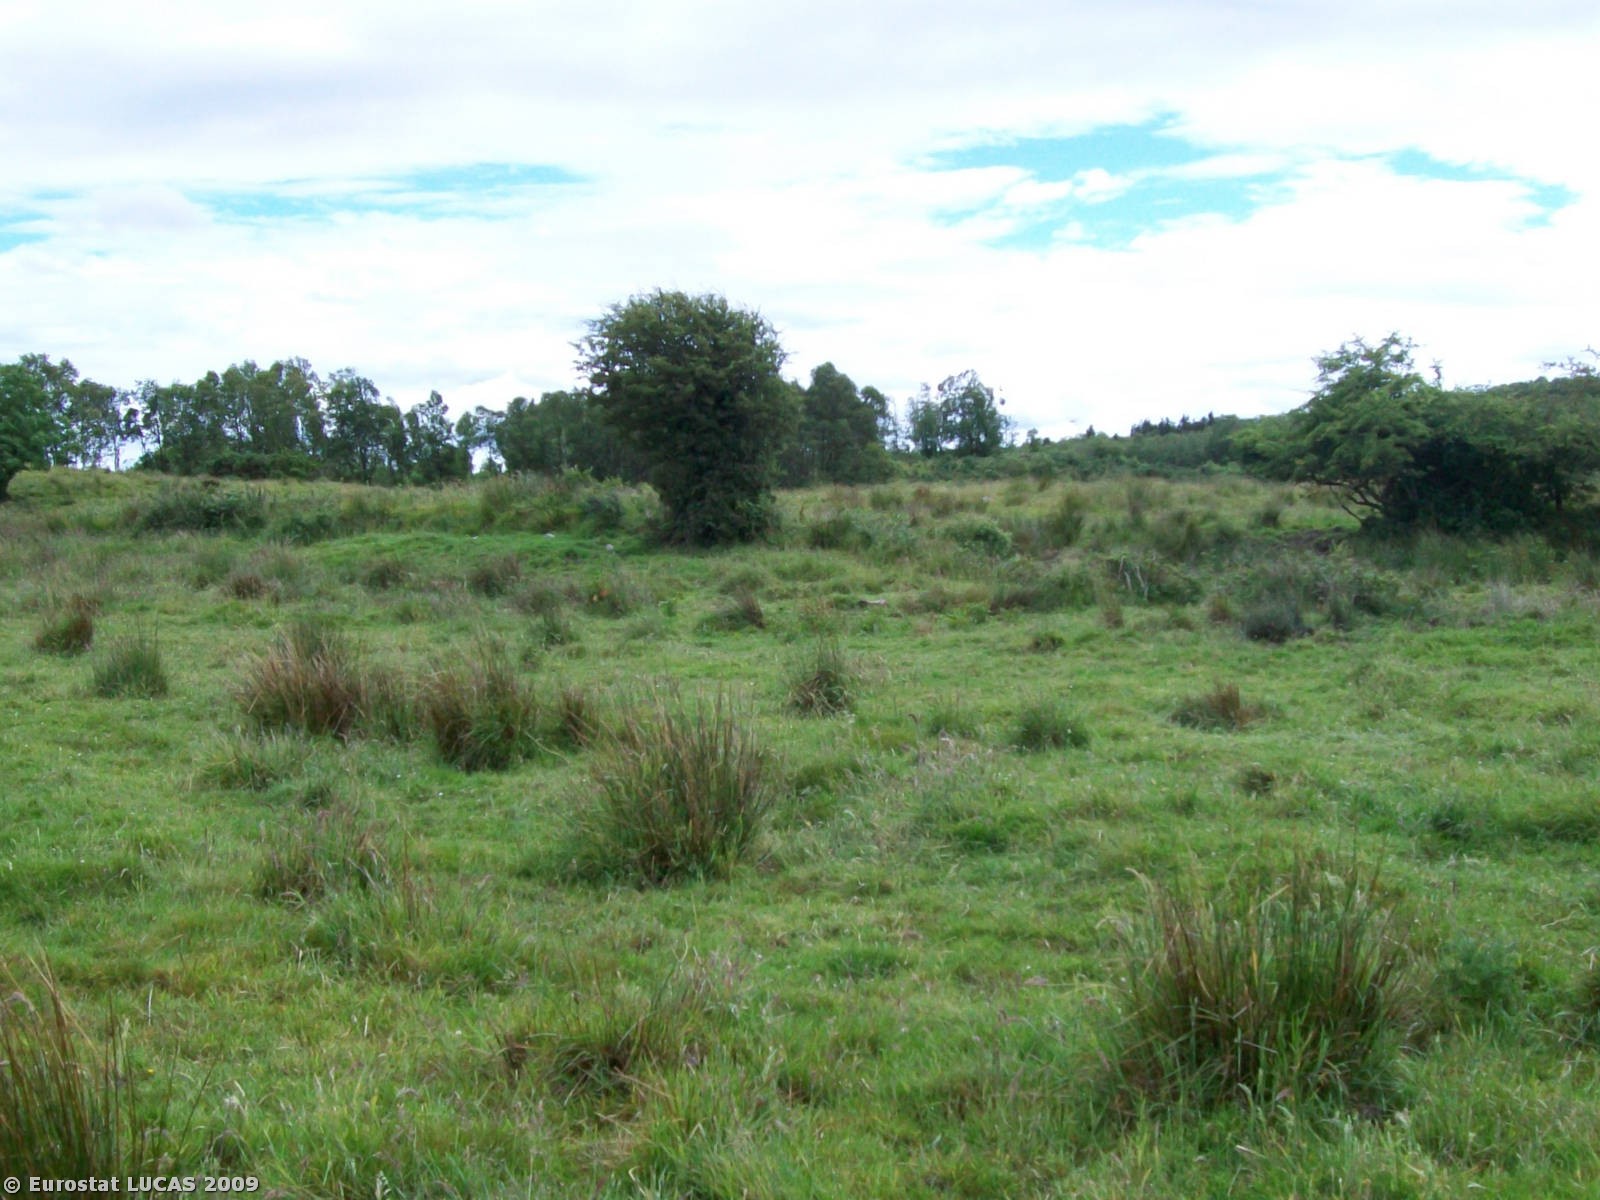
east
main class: Grassland
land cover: Grassland without tree/shrub cover
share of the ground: > 75 %
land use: Agriculture (excluding fallow land and kitchen gardens)
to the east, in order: Grassland without tree/shrub cover; Ditches and canals; Grassland without tree/shrub cover; Fences; Grassland without tree/shrub cover; Grass margins; Paved roads, cycling and walking lanes; Shrubland without tree cover
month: June
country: IE
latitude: 53.8153
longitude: -9.0316
